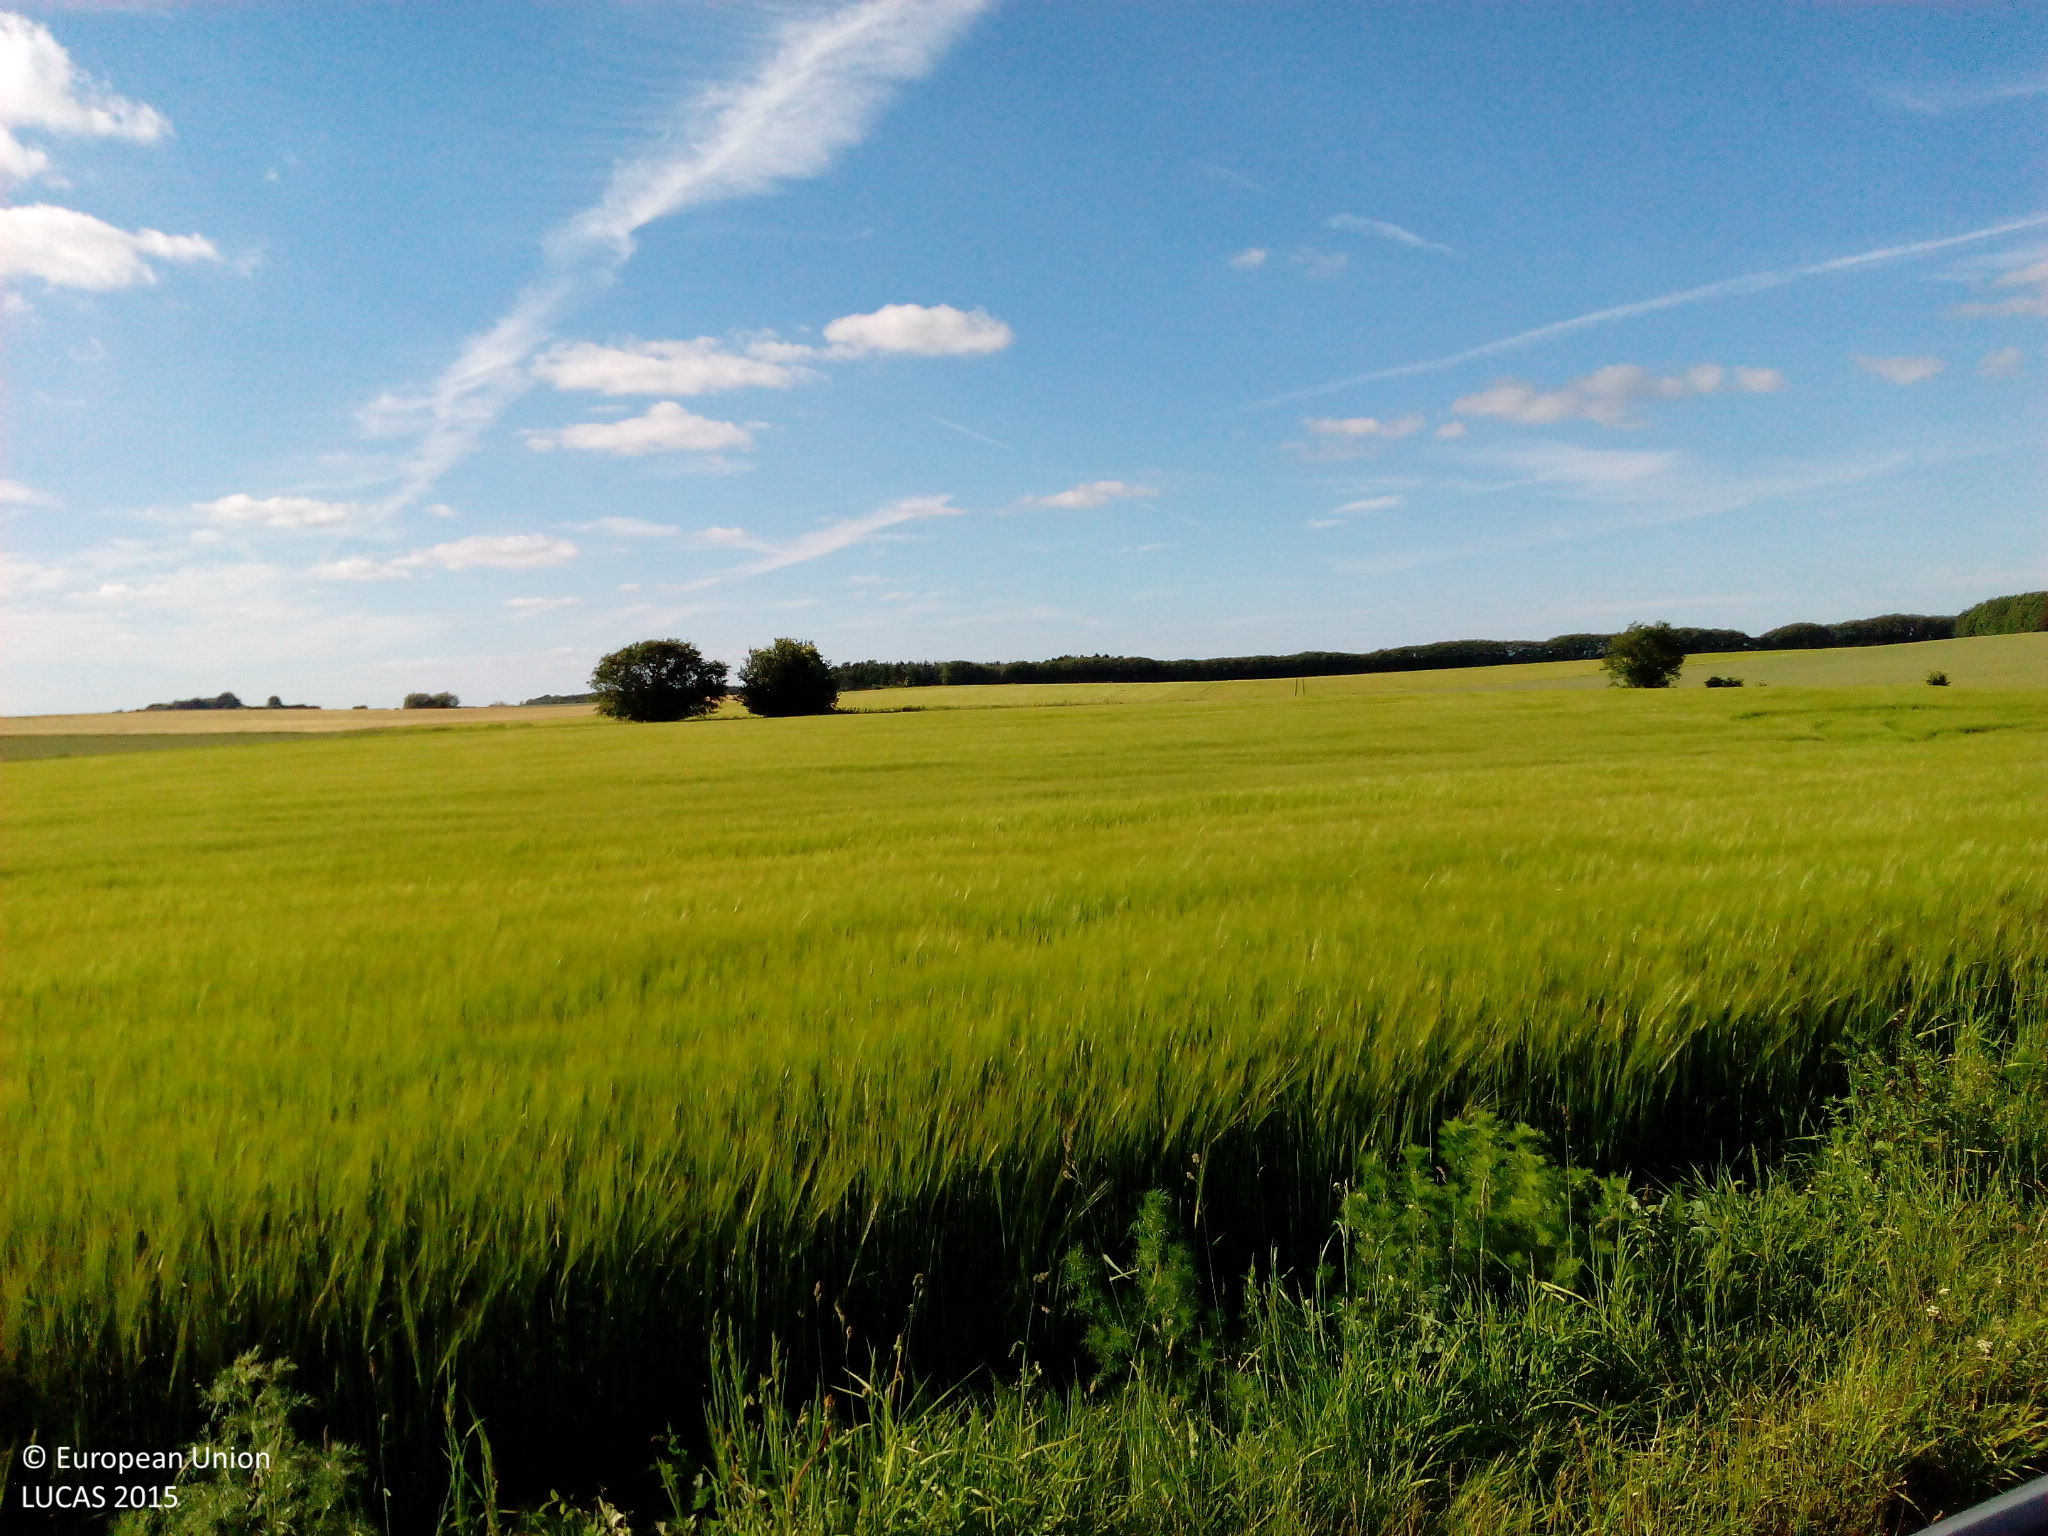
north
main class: Cropland
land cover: Rape and turnip rape
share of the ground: > 75 %
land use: Agriculture (excluding fallow land and kitchen gardens)
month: June
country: DK
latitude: 56.3298
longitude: 10.6623
